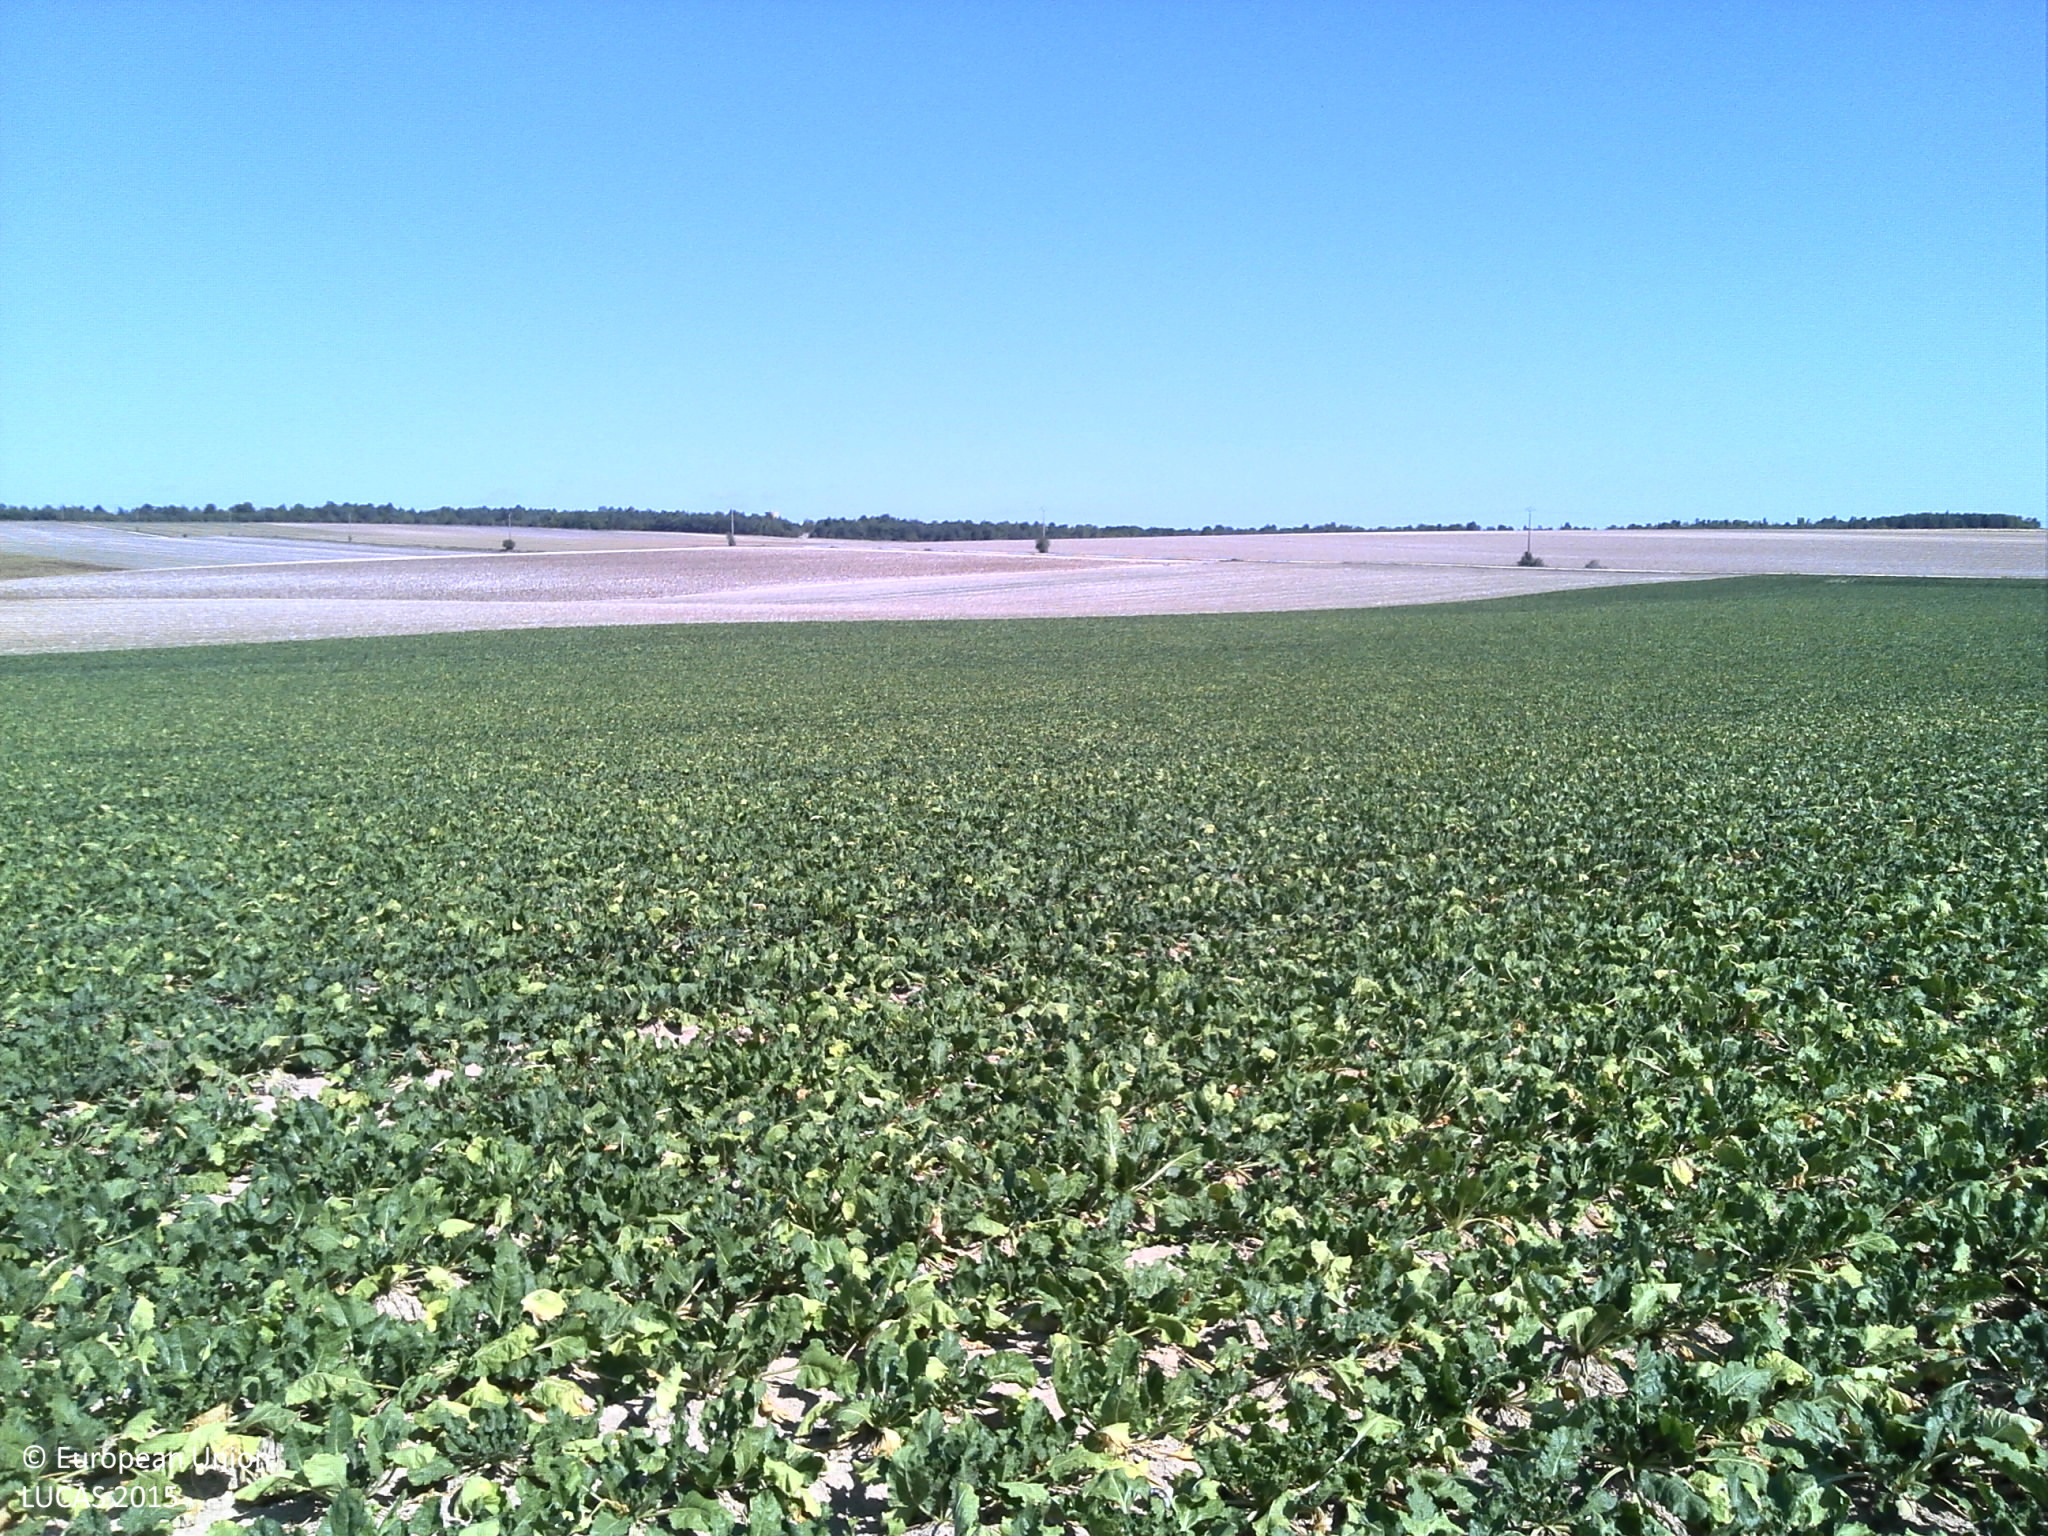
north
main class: Cropland
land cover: Sugar beet
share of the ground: > 75 %
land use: Agriculture (excluding fallow land and kitchen gardens)
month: August
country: FR
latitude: 48.5655
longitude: 4.3459
